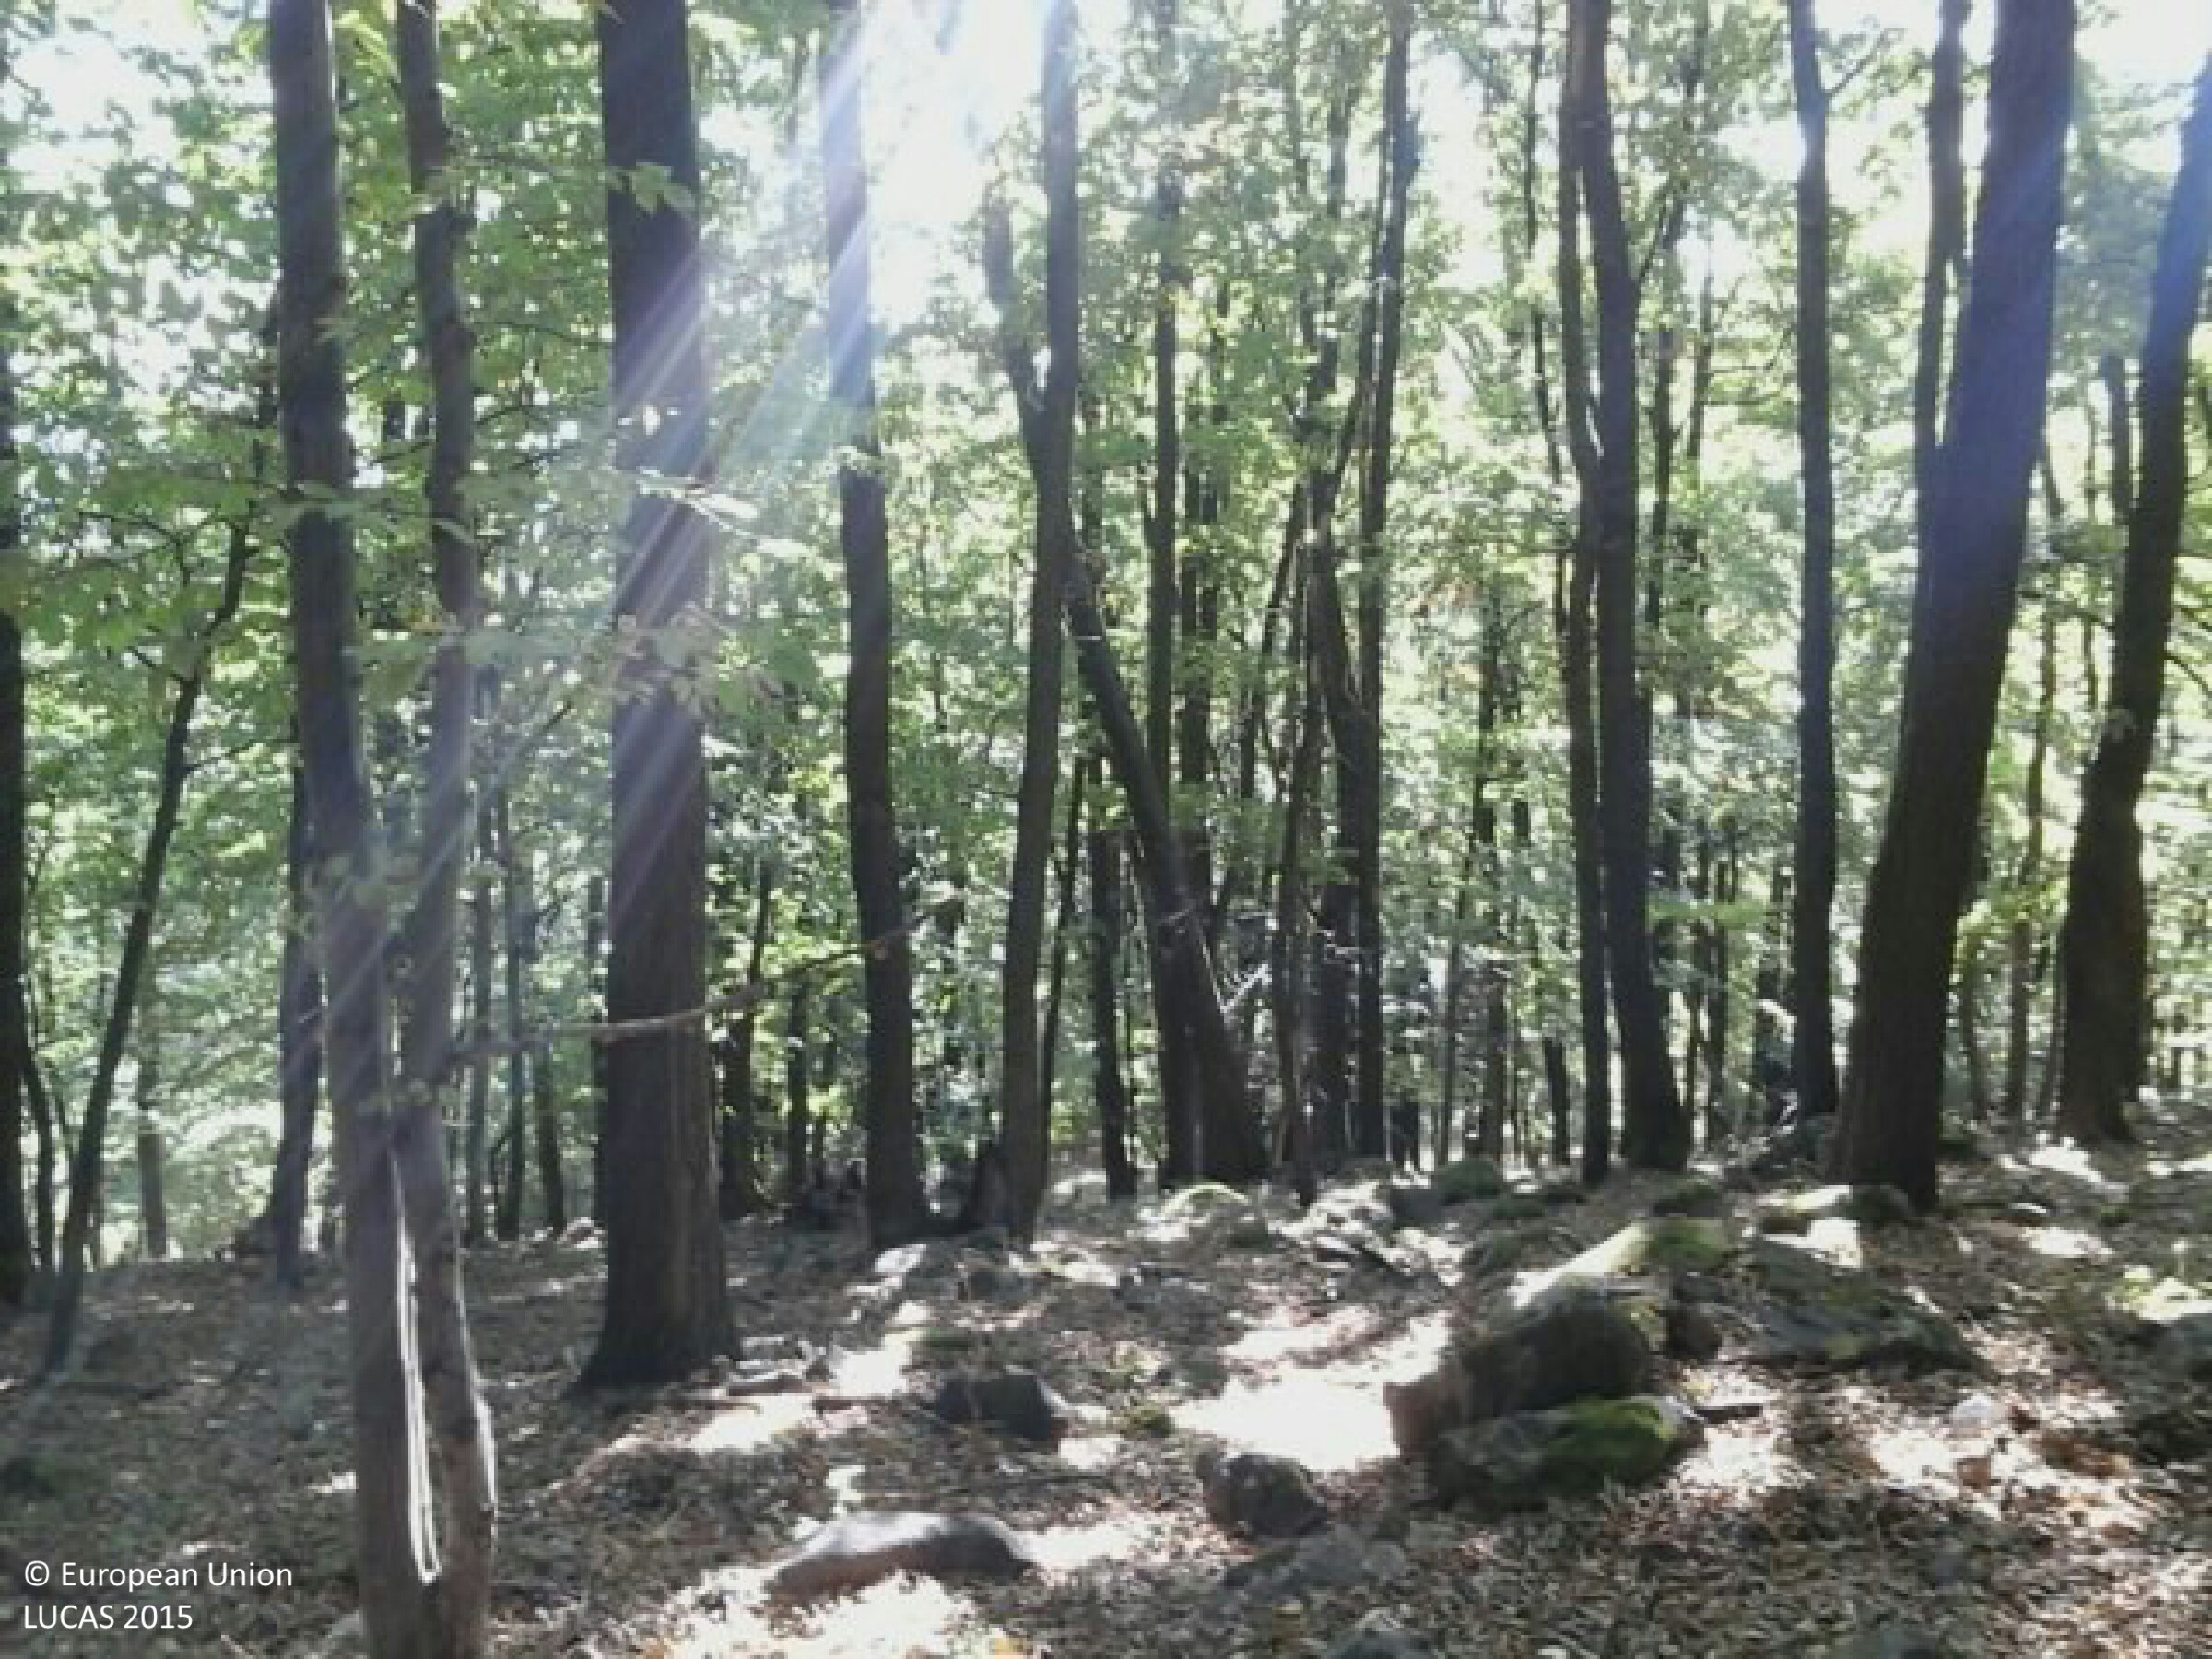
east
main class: Woodland
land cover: Broadleaved woodland
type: beech forest
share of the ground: > 75 %
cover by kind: broadleaved forest trees 100 %
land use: Forestry
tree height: > 5 m
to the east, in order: Broadleaved woodland
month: September
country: HU
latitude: 47.8896
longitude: 19.8562
